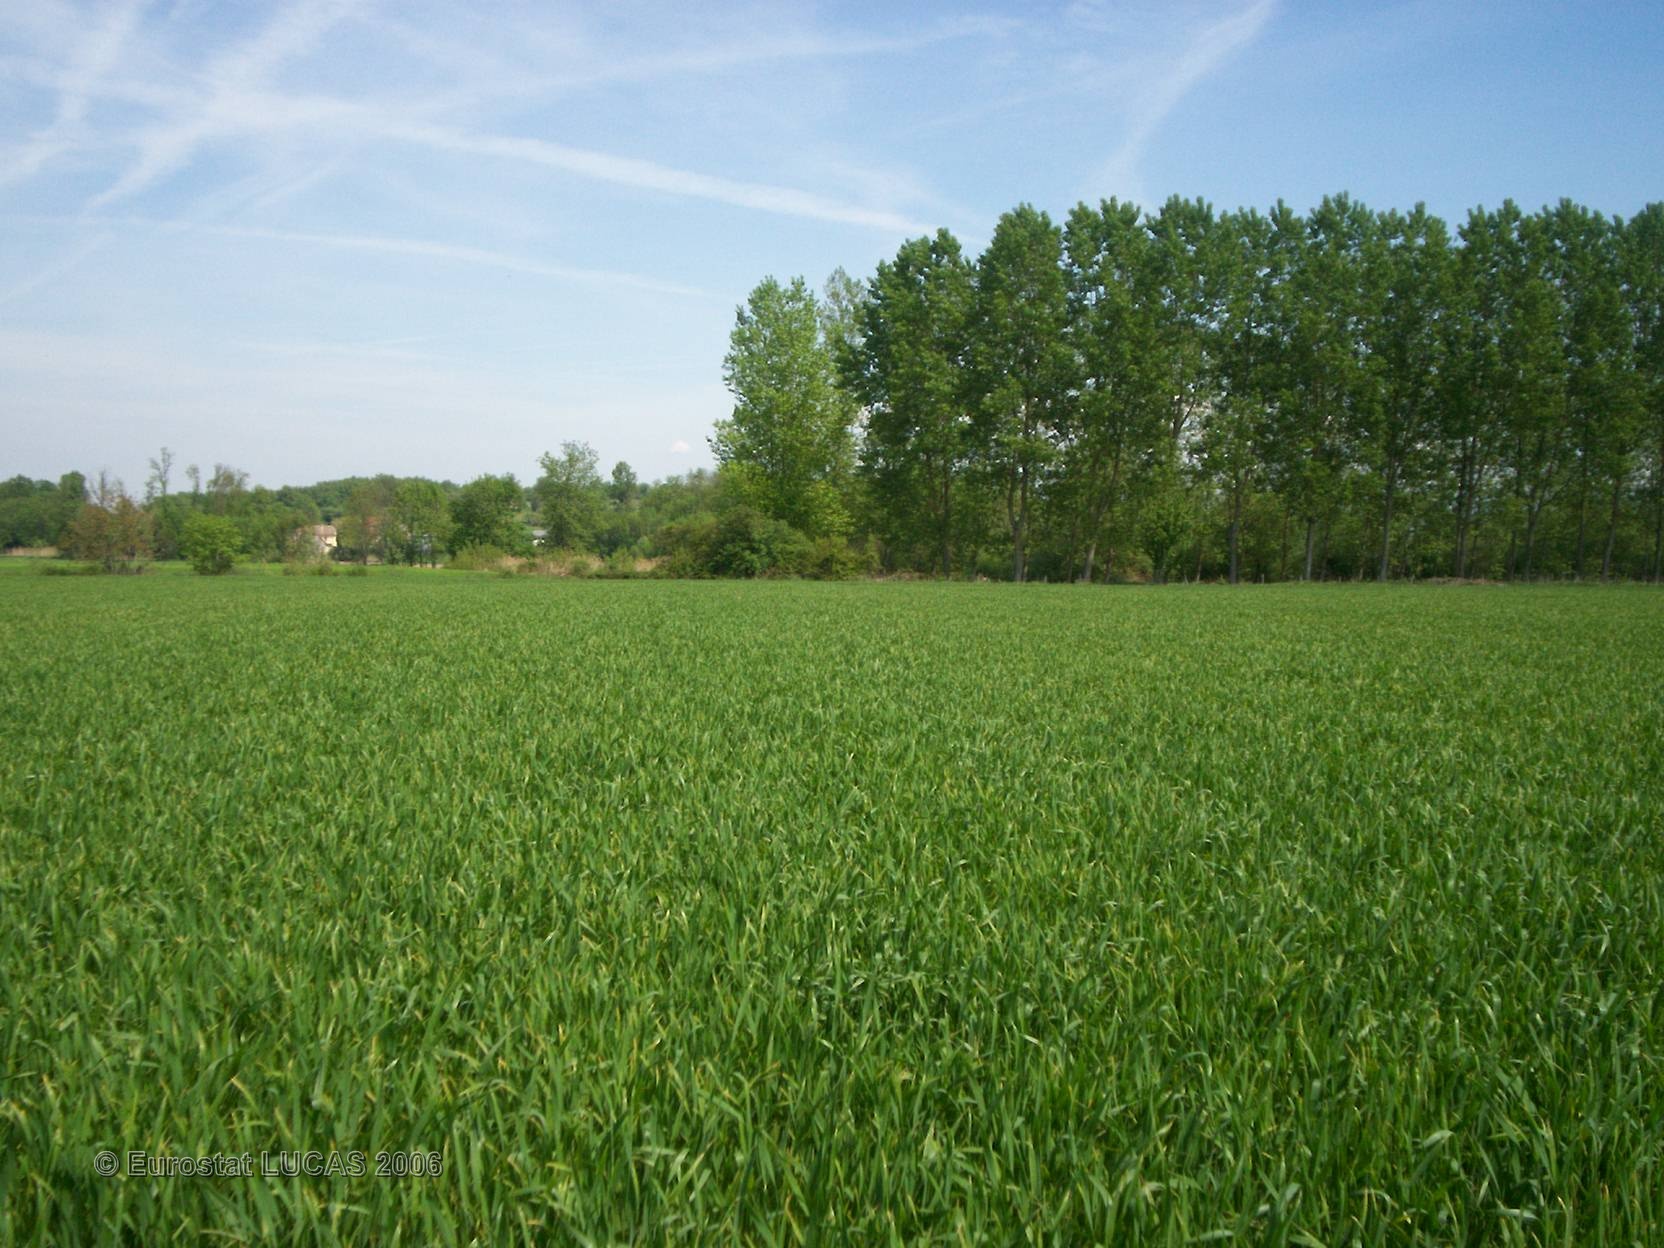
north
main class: Cropland
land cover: Common wheat
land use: Agriculture (excluding fallow land and kitchen gardens)
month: May
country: FR
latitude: 45.6938
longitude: 5.4197
